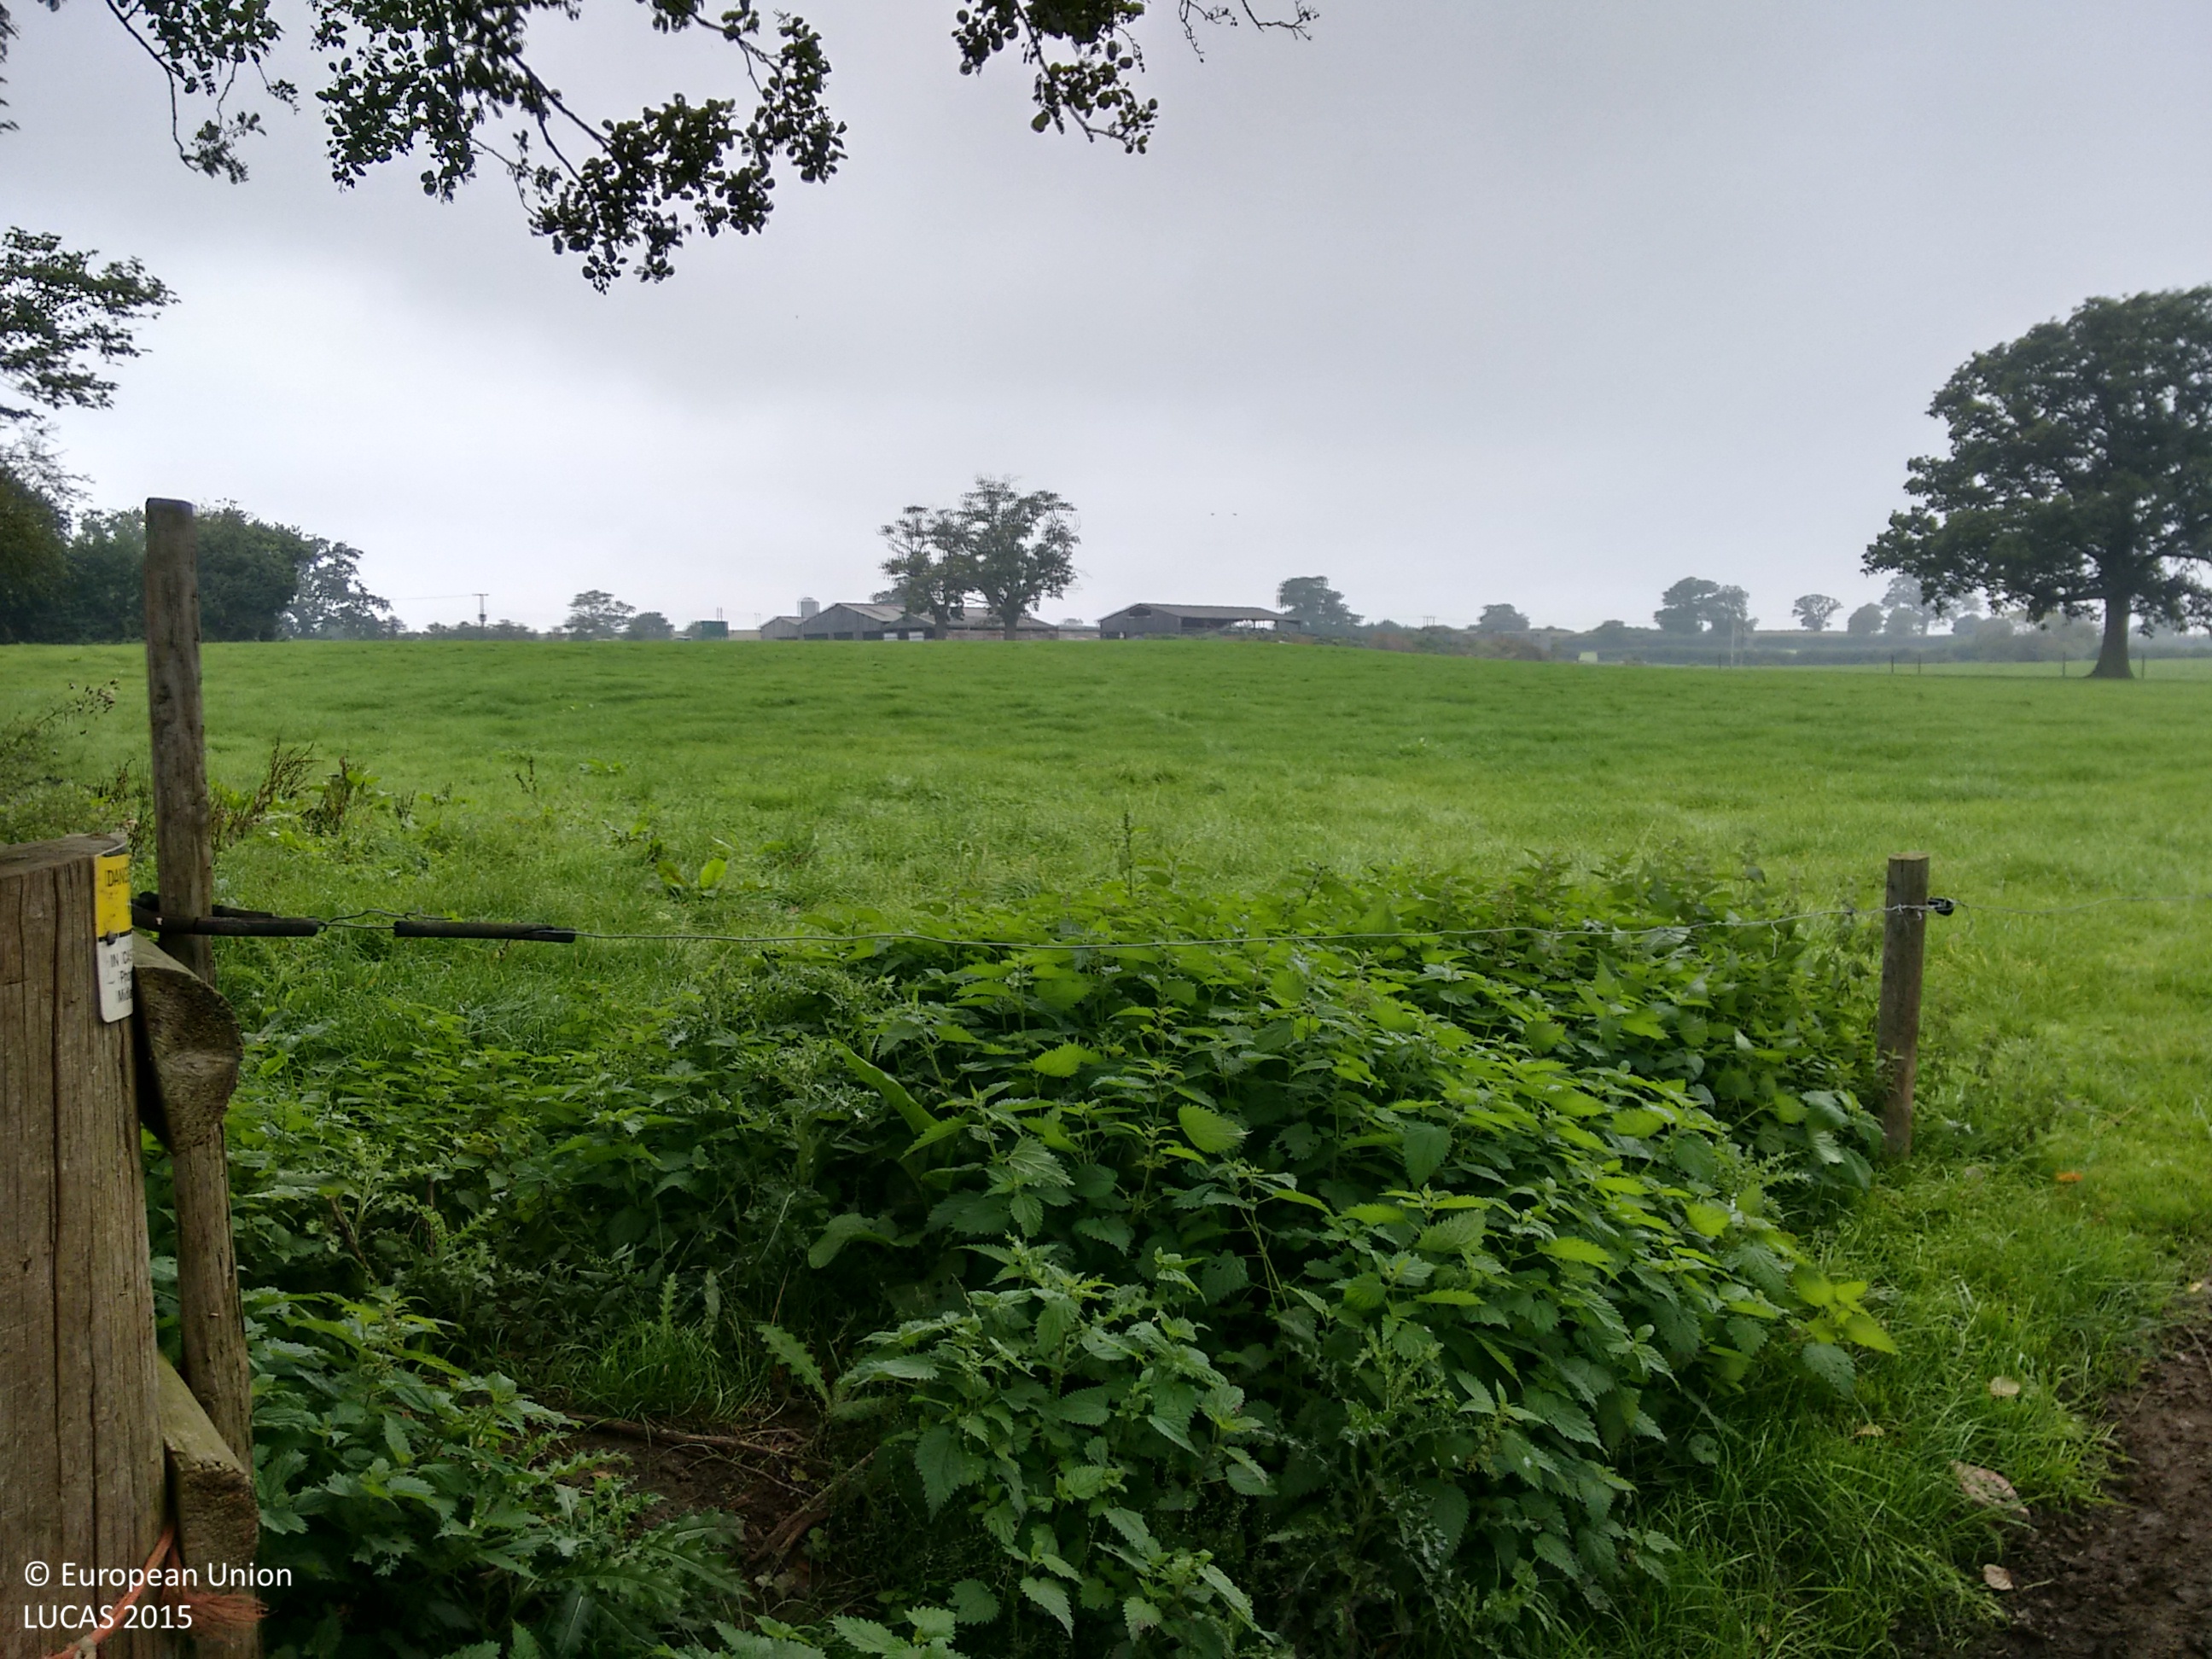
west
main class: Grassland
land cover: Grassland without tree/shrub cover
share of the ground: > 75 %
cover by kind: herbaceous plants 100 %
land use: Agriculture (excluding fallow land and kitchen gardens)
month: September
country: GB
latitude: 52.6547
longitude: -2.8896
